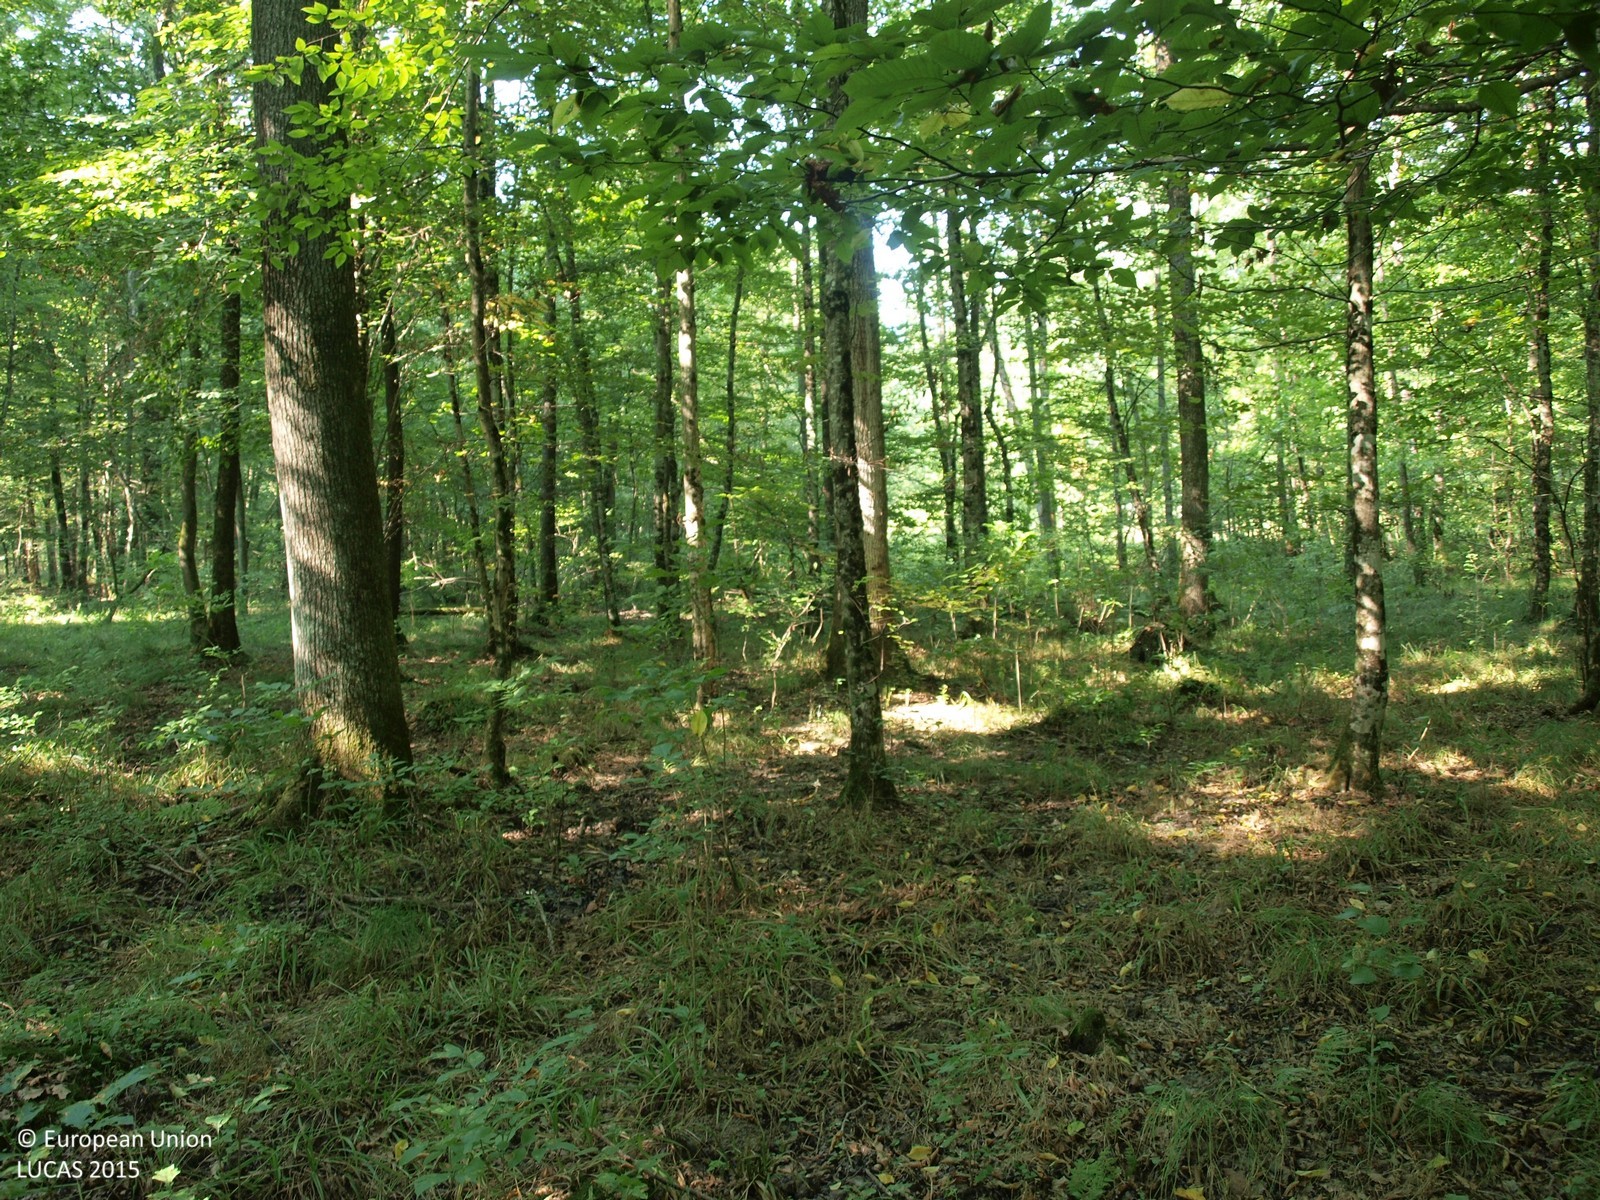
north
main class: Woodland
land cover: Broadleaved woodland
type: floodplain forest
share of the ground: > 75 %
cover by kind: broadleaved forest trees 100 %
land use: Forestry
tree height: > 5 m
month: August
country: HR
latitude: 45.6145
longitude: 16.4487
